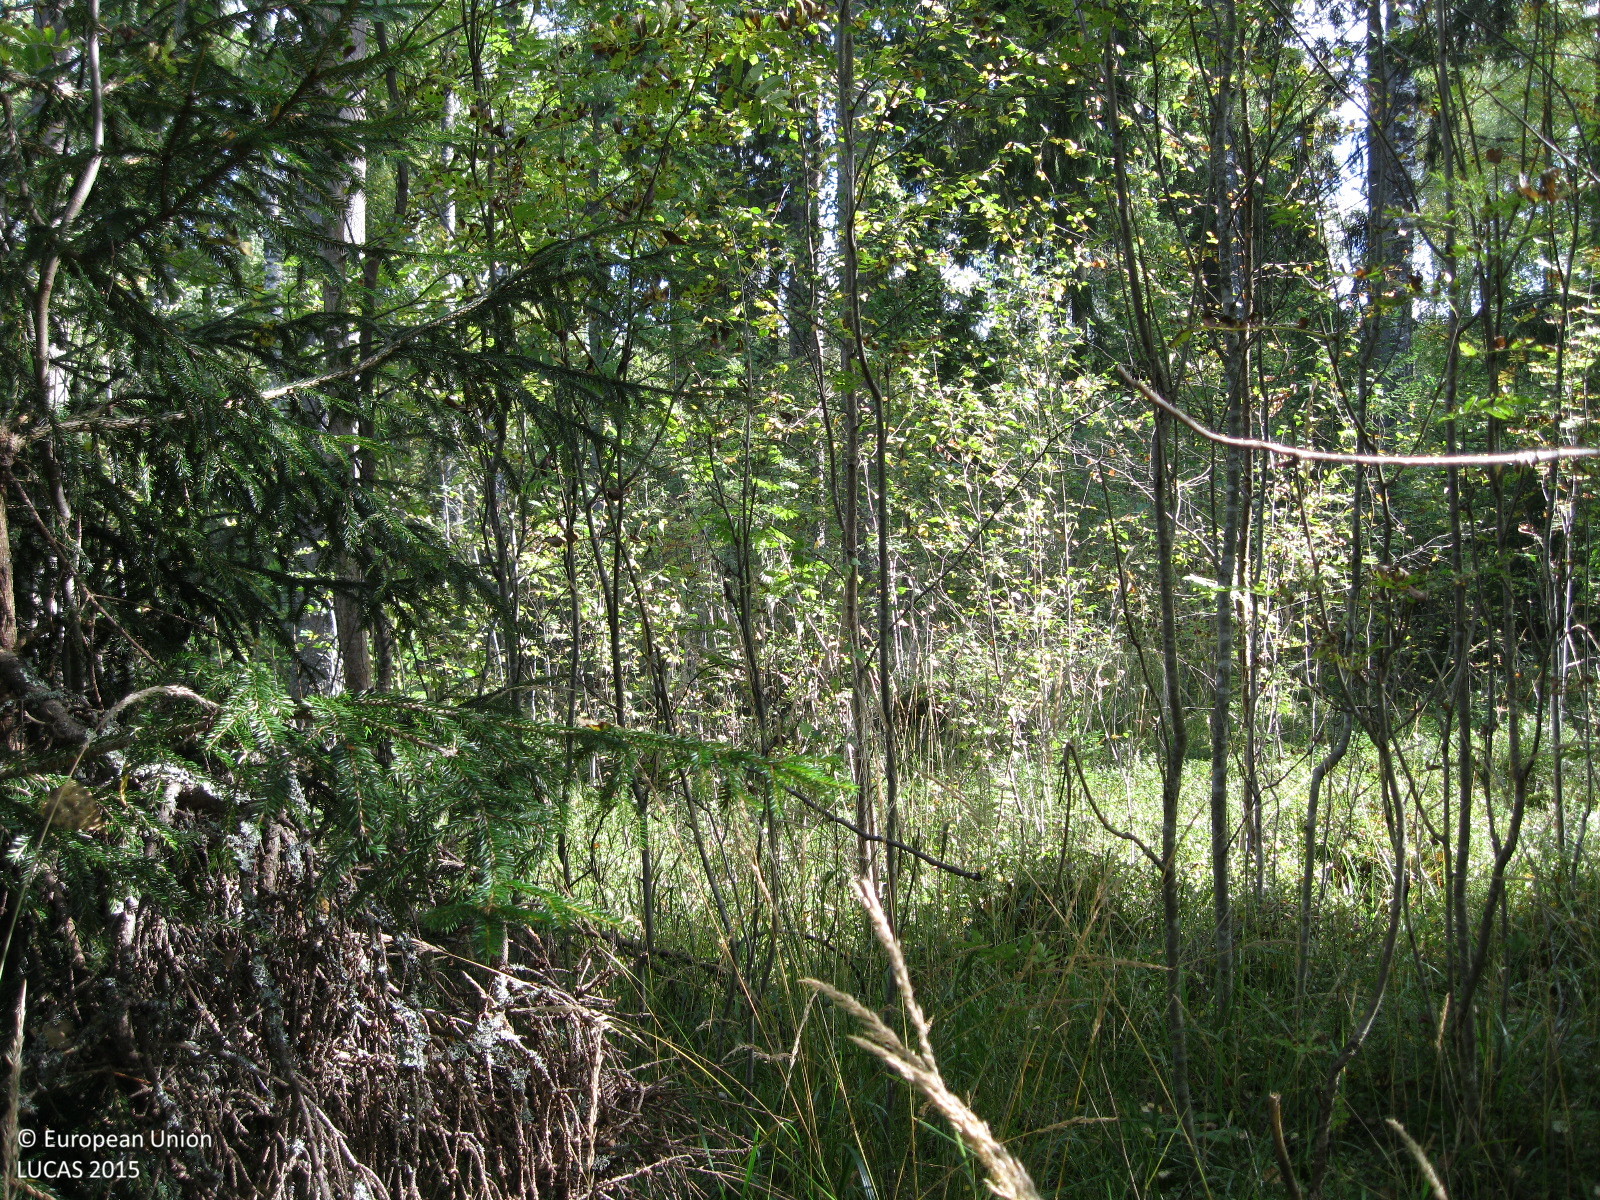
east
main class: Woodland
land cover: Broadleaved woodland
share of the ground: > 75 %
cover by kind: broadleaved forest trees 90 %, shrubs 5 %, herbaceous plants 5 %
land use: Forestry
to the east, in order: Broadleaved woodland; Spruce dominated mixed woodland; Broadleaved woodland; Pine dominated mixed woodland; Broadleaved woodland; Spruce dominated coniferous woodland; Spruce dominated mixed woodland
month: September
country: FI
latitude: 60.3773
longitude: 24.5267
